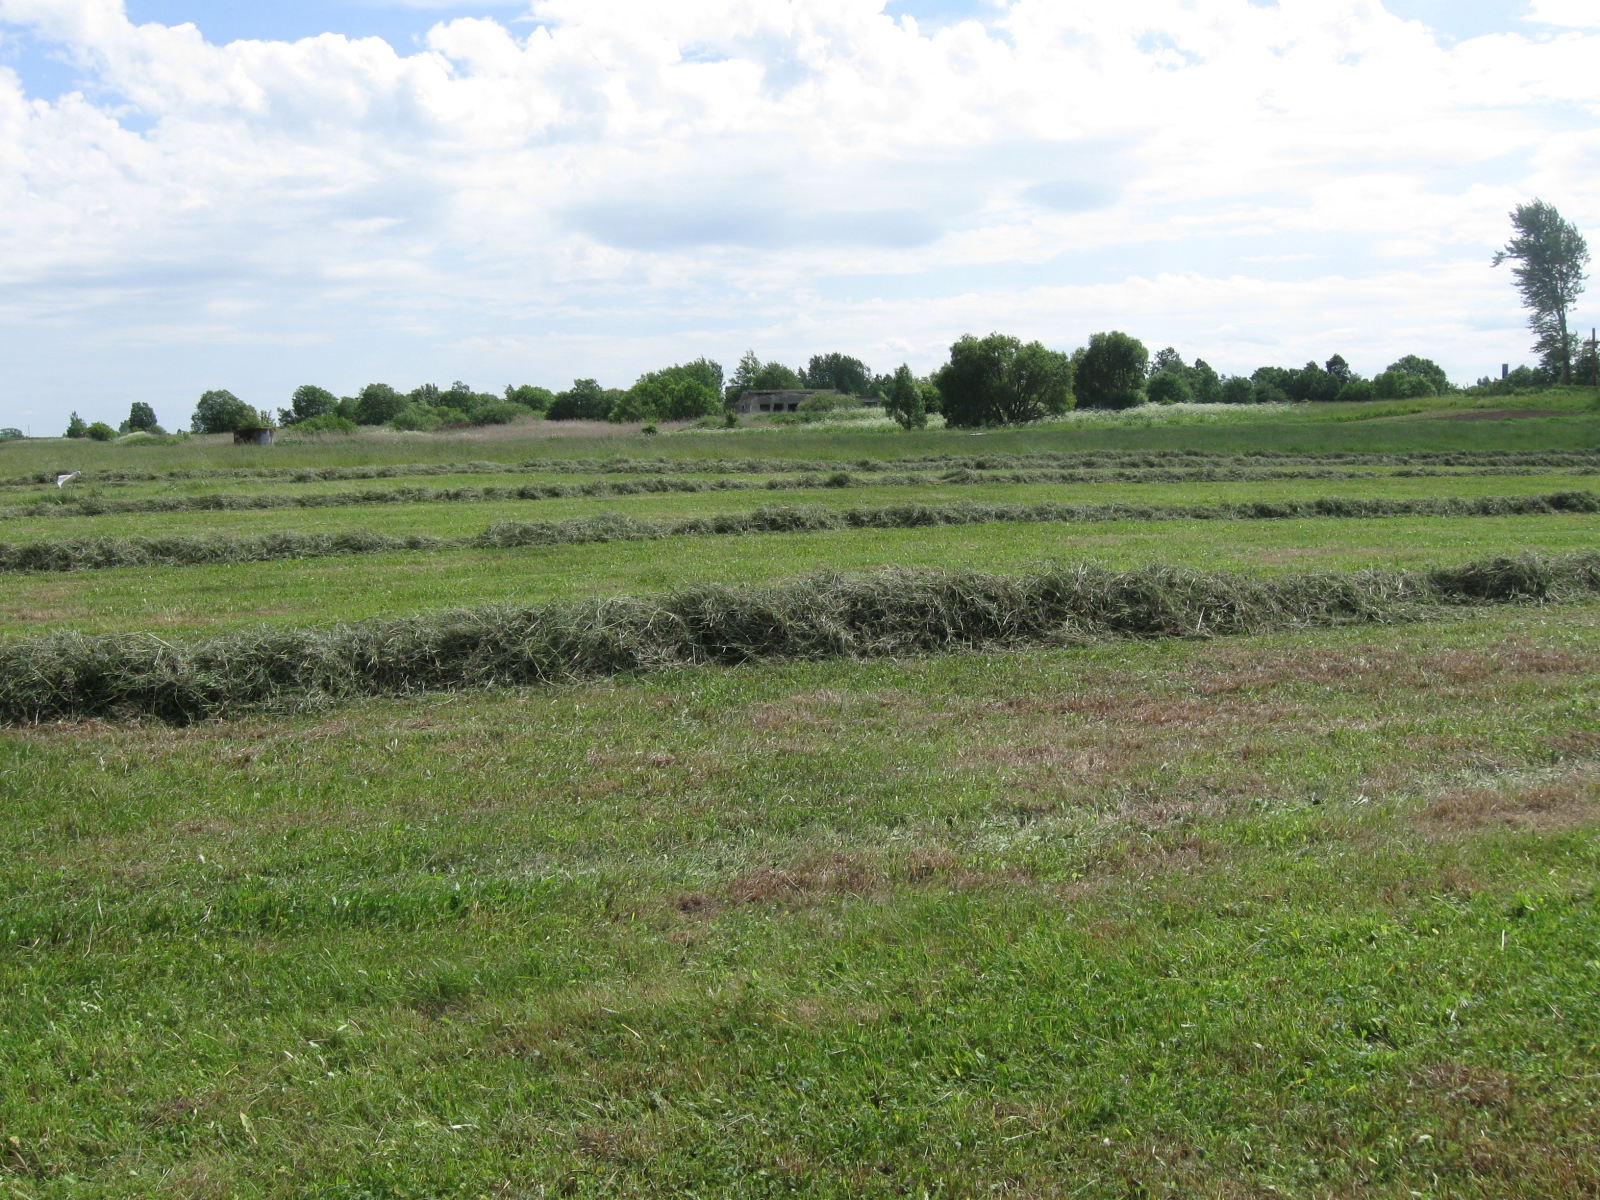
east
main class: Grassland
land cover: Grassland without tree/shrub cover
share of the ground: > 75 %
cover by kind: herbaceous plants 95 %, unconsolidated bare surface 5 %
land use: Agriculture (excluding fallow land and kitchen gardens)
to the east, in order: Grassland without tree/shrub cover; Spontaneously vegetated surfaces; Ponds and wetlands; Spontaneously vegetated surfaces
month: June
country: LT
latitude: 54.3907
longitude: 23.6843
